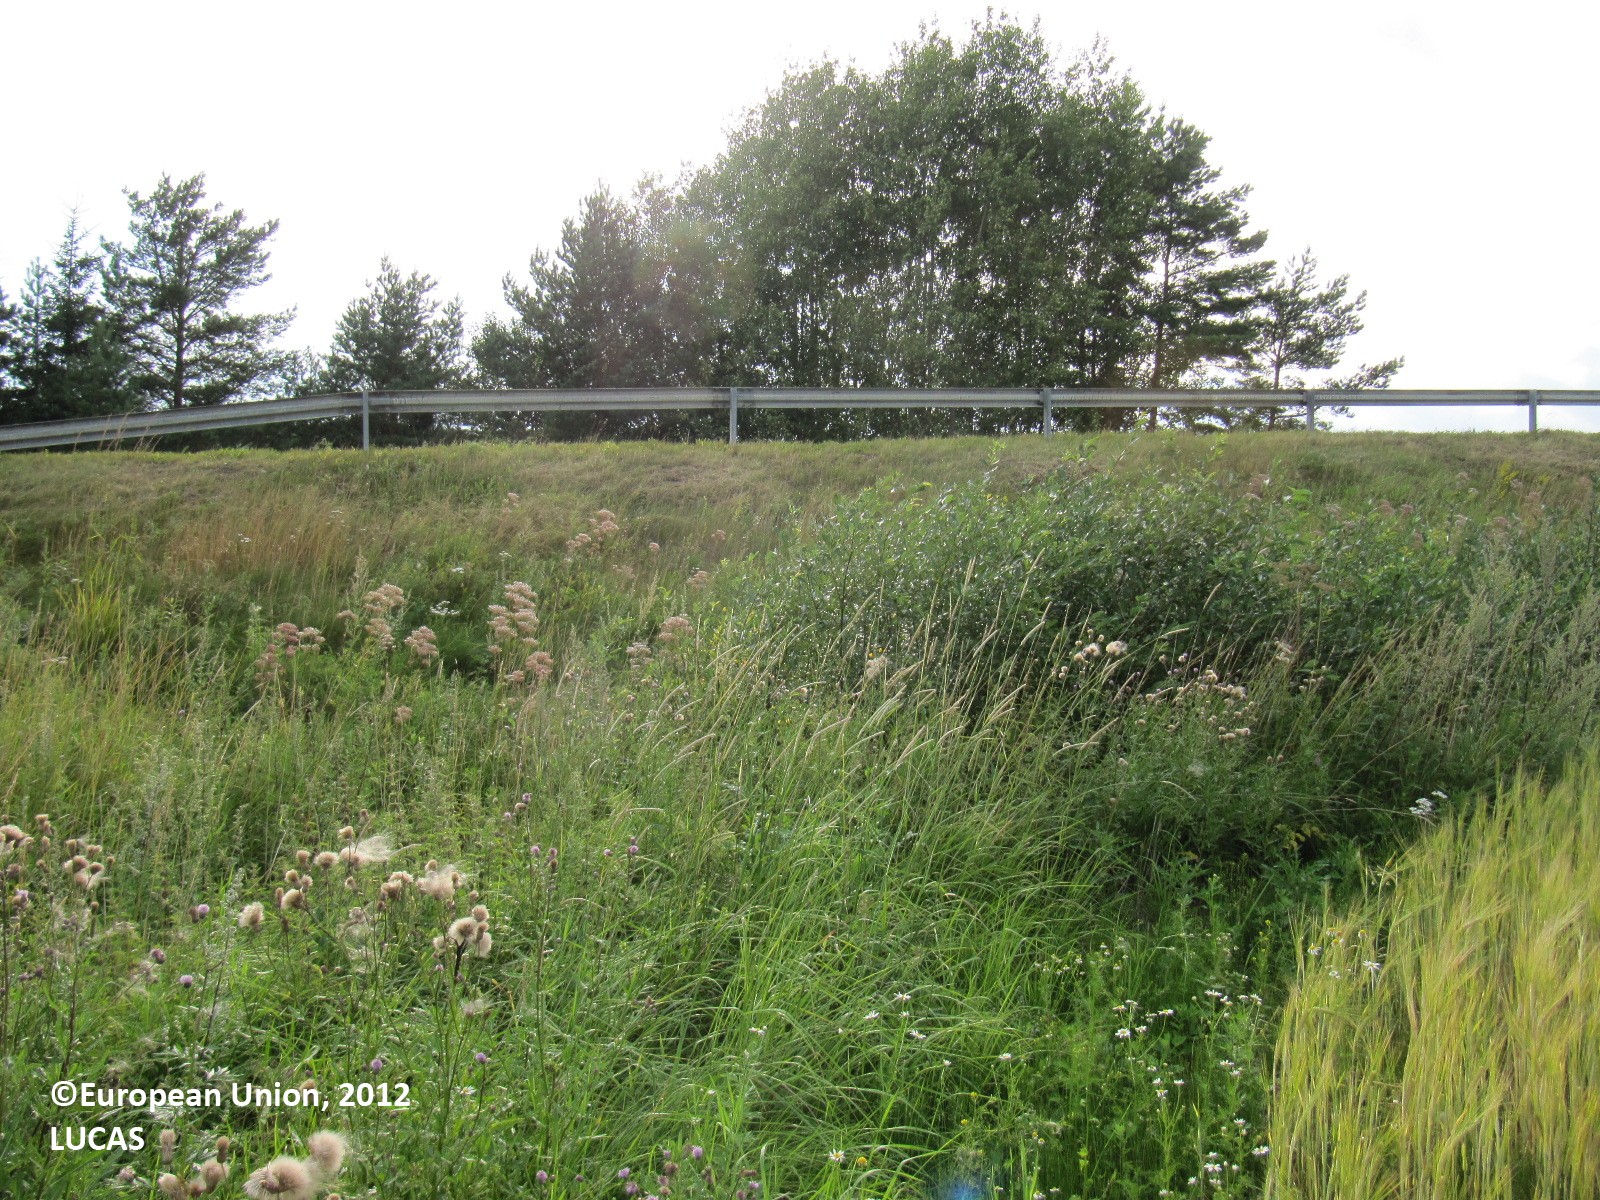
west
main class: Cropland
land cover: Barley
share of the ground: > 75 %
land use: Agriculture (excluding fallow land and kitchen gardens)
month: August
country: FI
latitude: 60.3163
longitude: 23.0971
